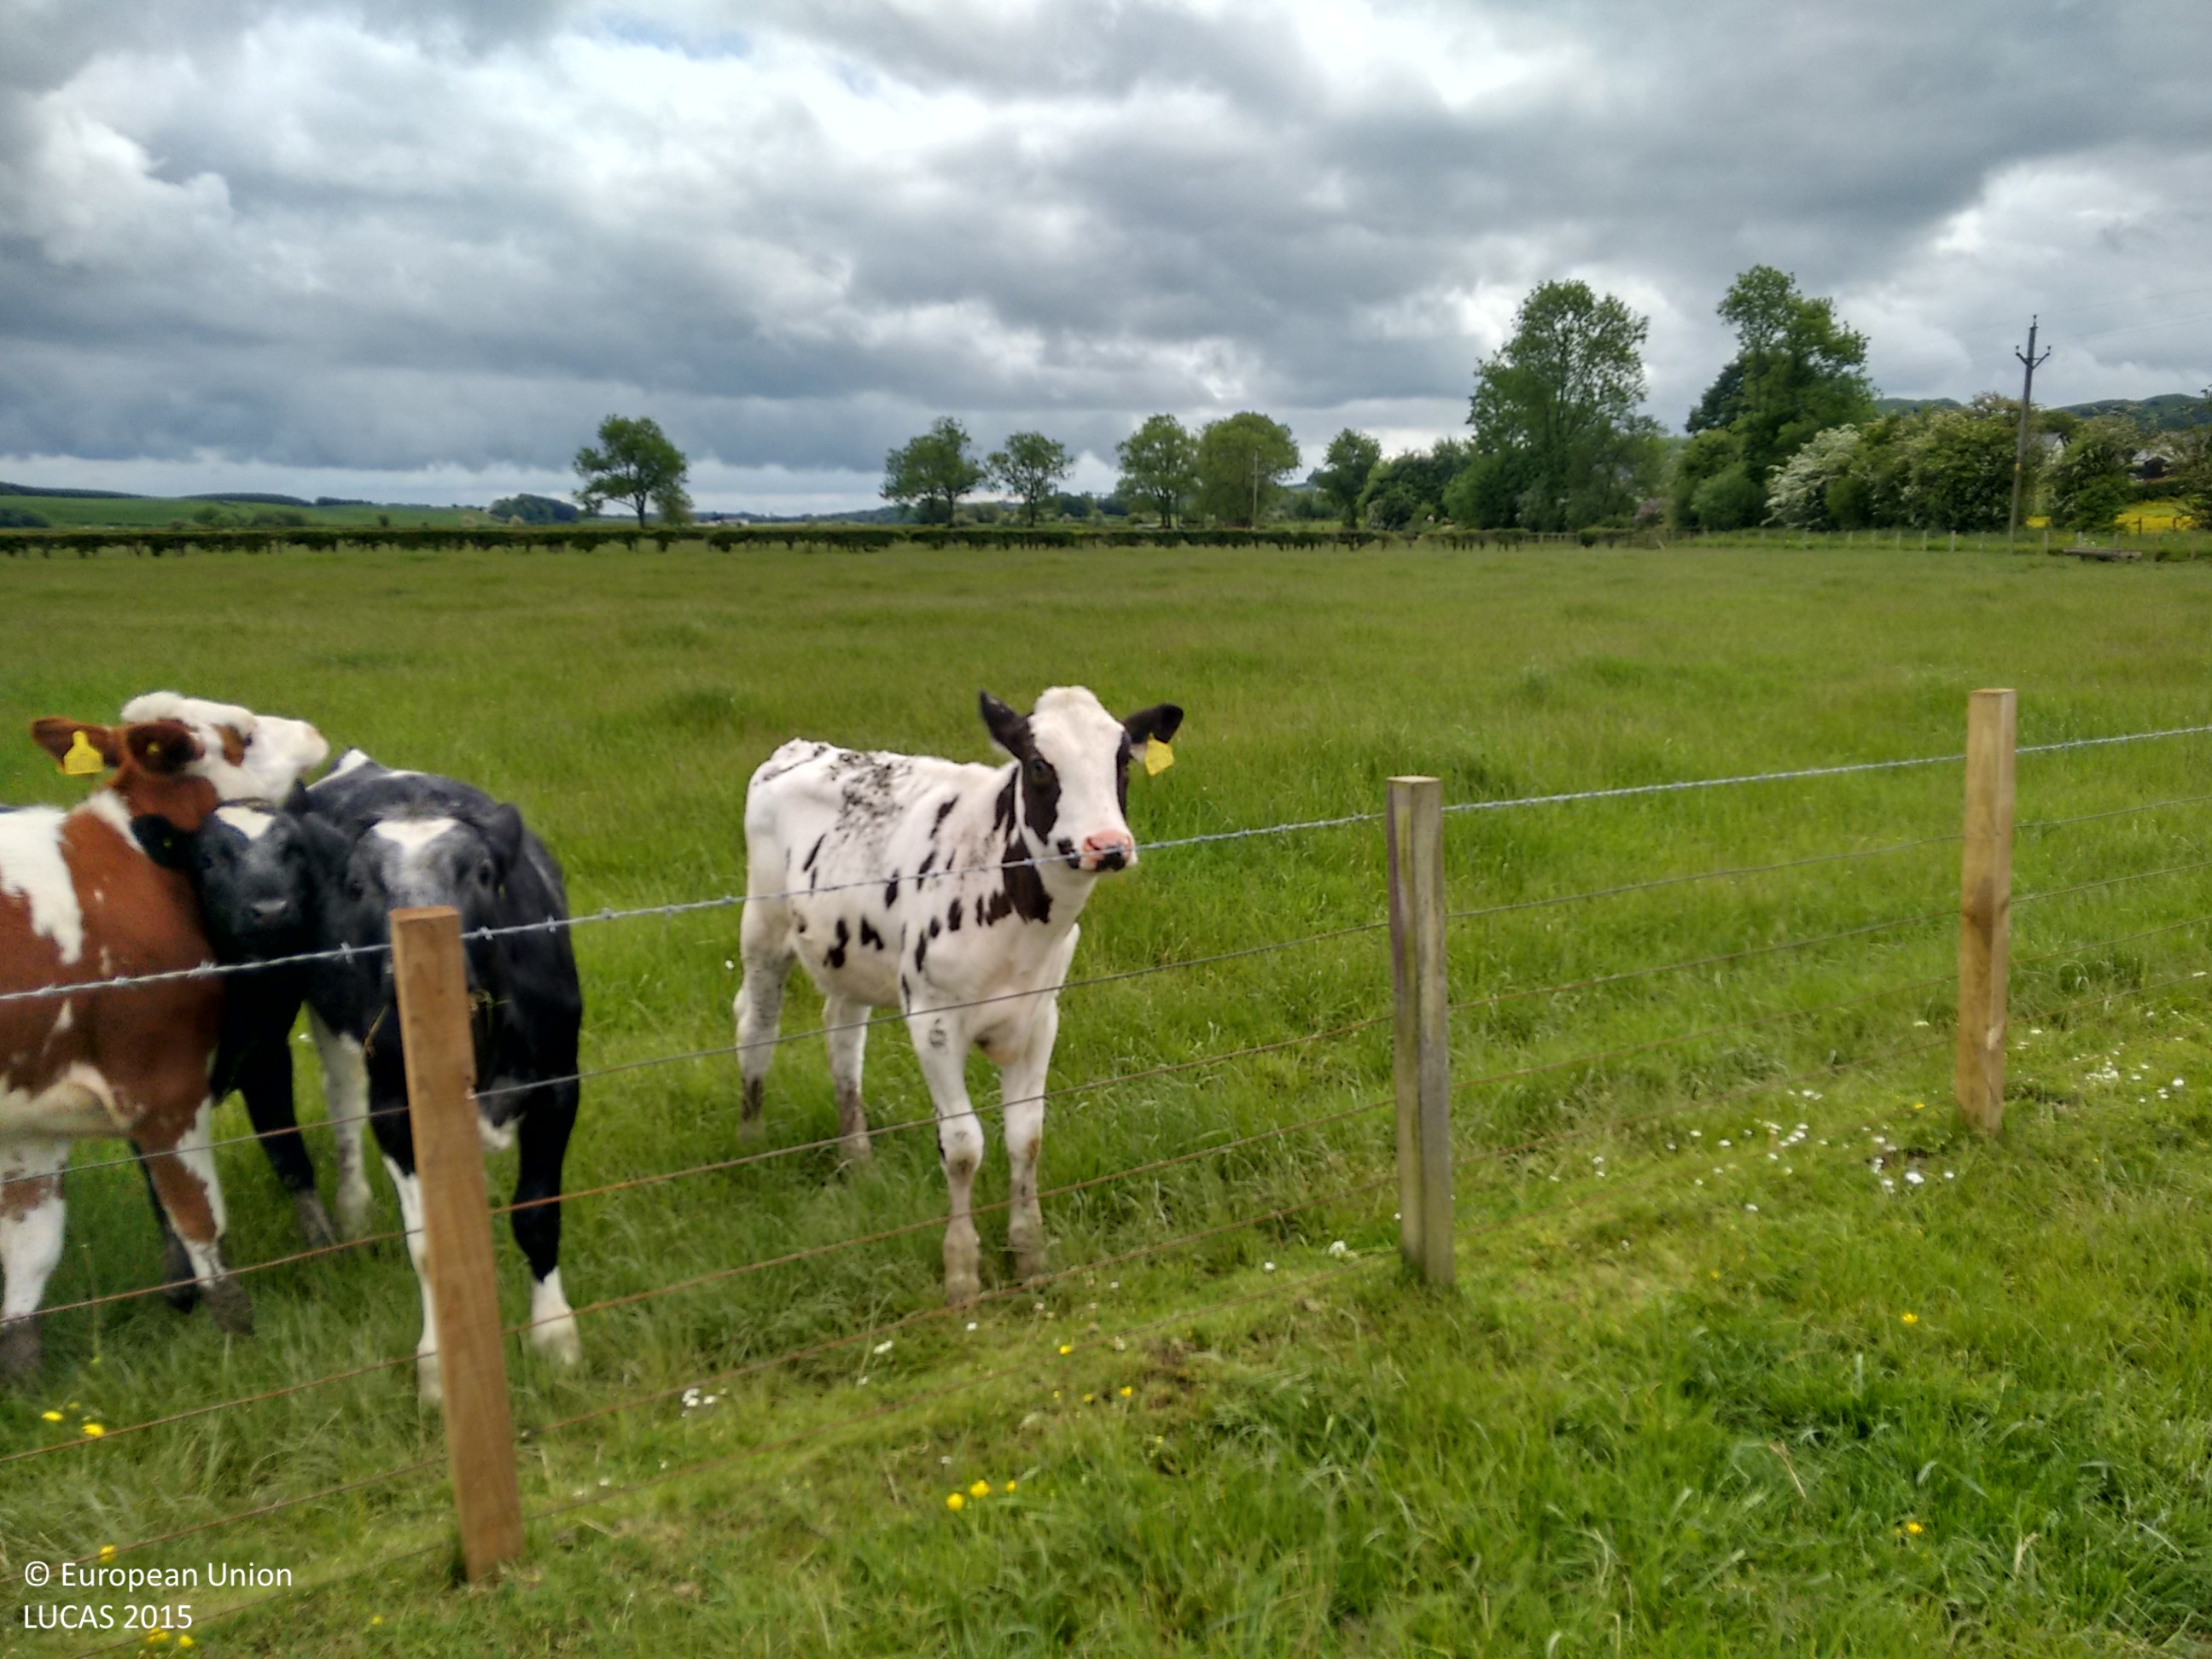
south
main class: Grassland
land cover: Grassland without tree/shrub cover
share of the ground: > 75 %
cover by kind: herbaceous plants 100 %
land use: Agriculture (excluding fallow land and kitchen gardens)
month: June
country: GB
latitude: 55.0958
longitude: -3.4142
